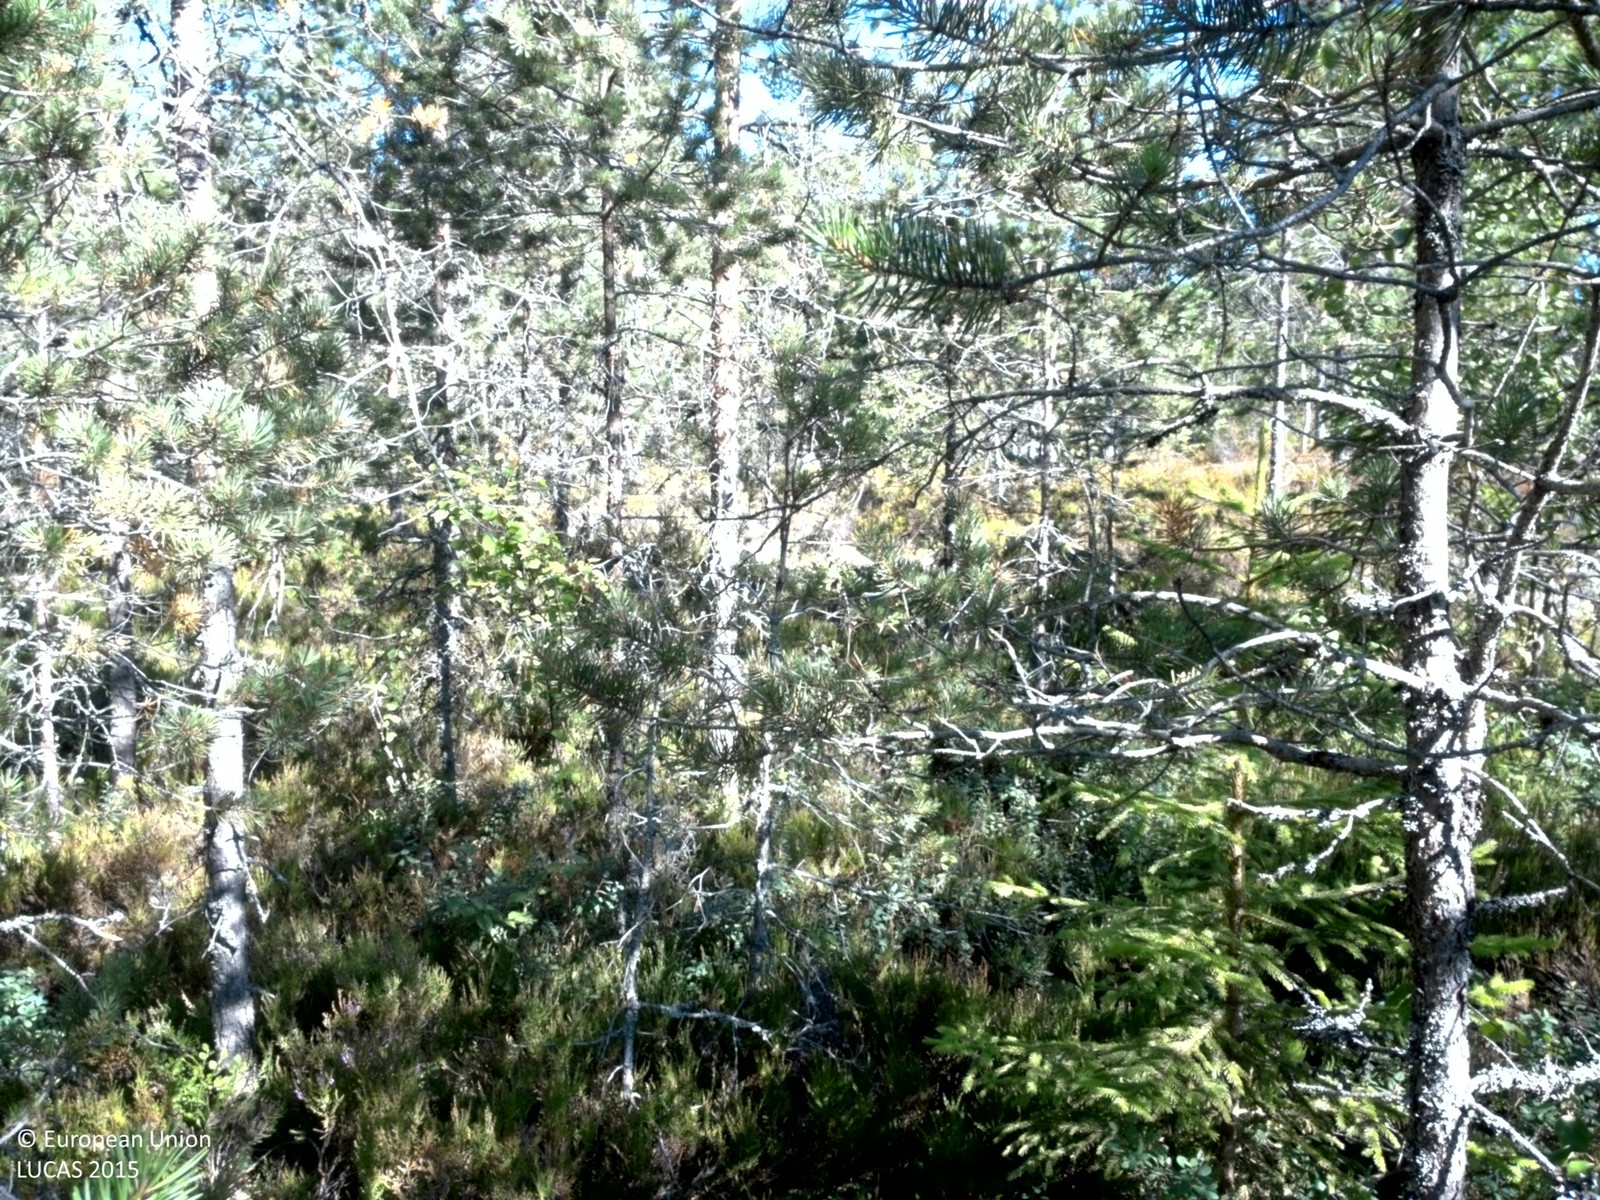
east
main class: Woodland
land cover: Other coniferous woodland
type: boreal forest
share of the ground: 50 - 75 %
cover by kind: coniferous forest trees 60 %, shrubs 30 %, broadleaved forest trees 5 %, lichens and mosses 5 %
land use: Forestry
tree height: > 5 m
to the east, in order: Other coniferous woodland; Pine dominated coniferous woodland
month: August
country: SE
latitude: 59.9391
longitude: 14.1601
